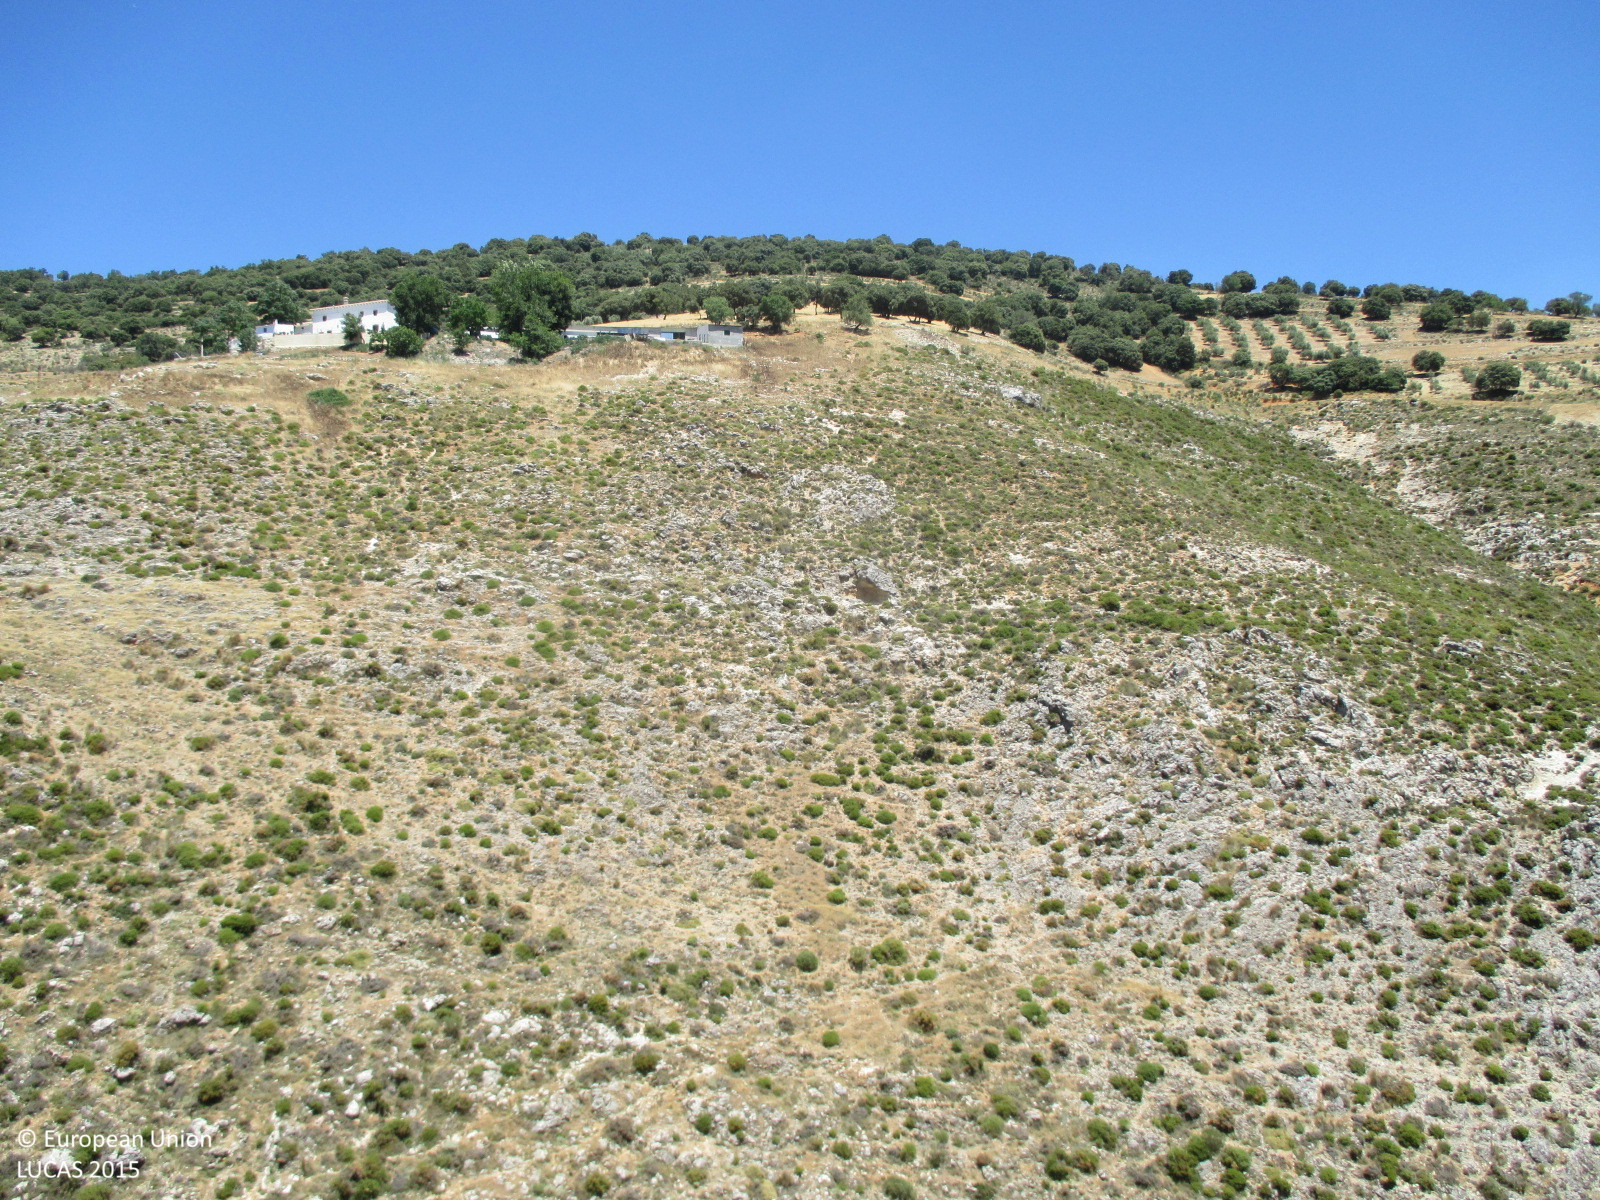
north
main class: Shrubland
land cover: Shrubland without tree cover
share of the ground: > 75 %
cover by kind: shrubs 60 %, herbaceous plants 40 %
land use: Semi-natural and natural areas not in use
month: June
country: ES
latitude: 37.4949
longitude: -3.7611
